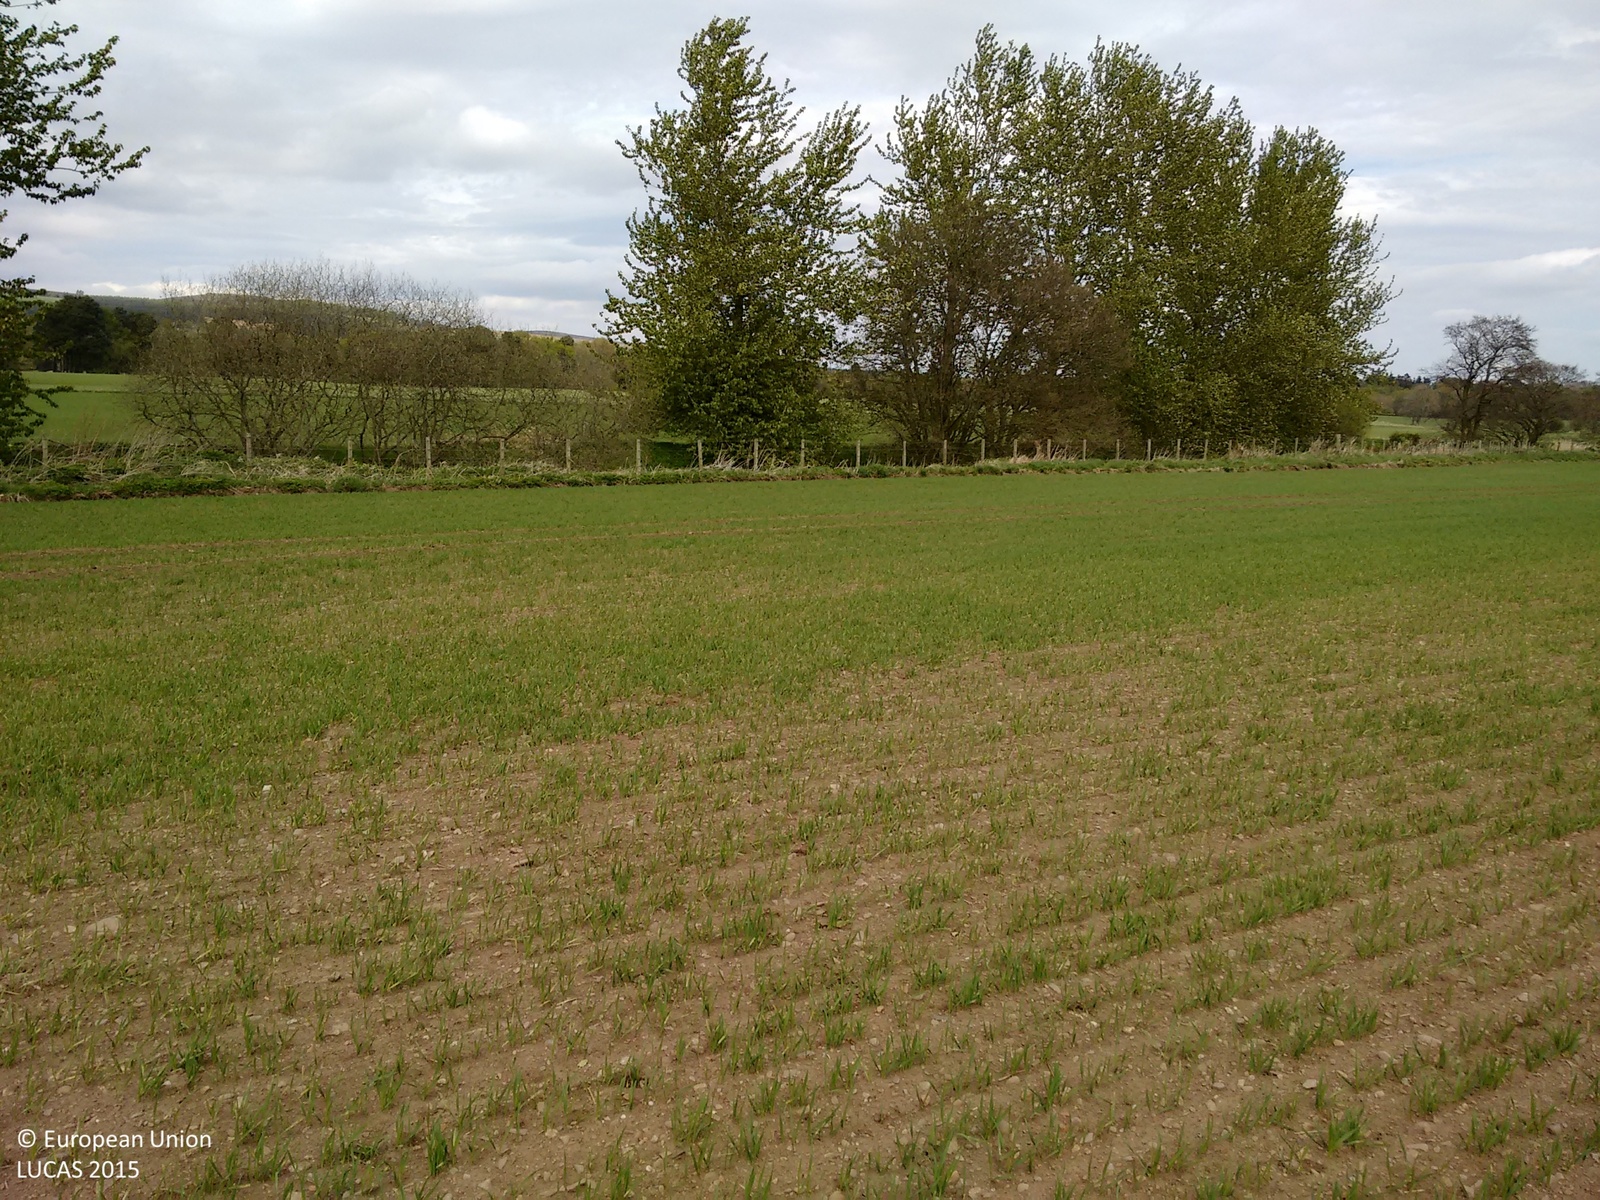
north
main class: Cropland
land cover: Oats
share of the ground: 50 - 75 %
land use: Agriculture (excluding fallow land and kitchen gardens)
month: May
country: GB
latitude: 56.7532
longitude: -2.7349
